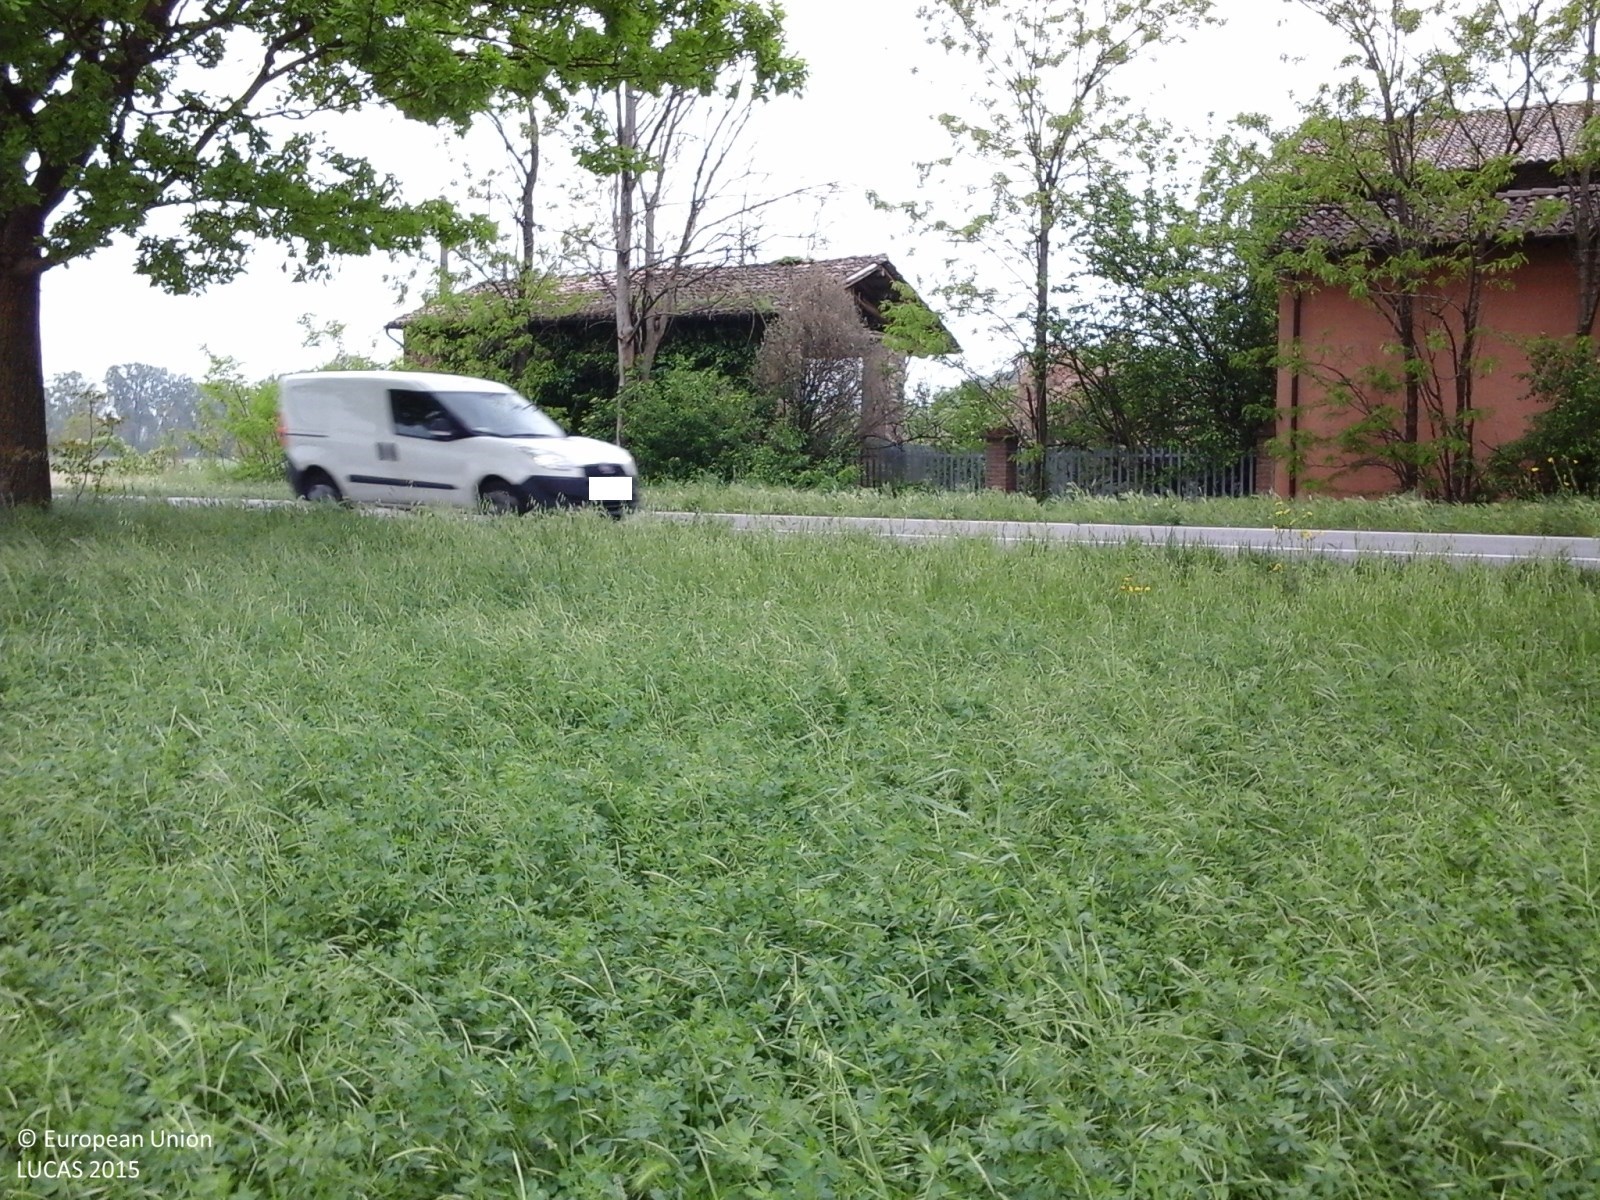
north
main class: Cropland
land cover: Lucerne
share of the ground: > 75 %
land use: Agriculture (excluding fallow land and kitchen gardens)
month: April
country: IT
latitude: 45.0167
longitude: 9.5314
